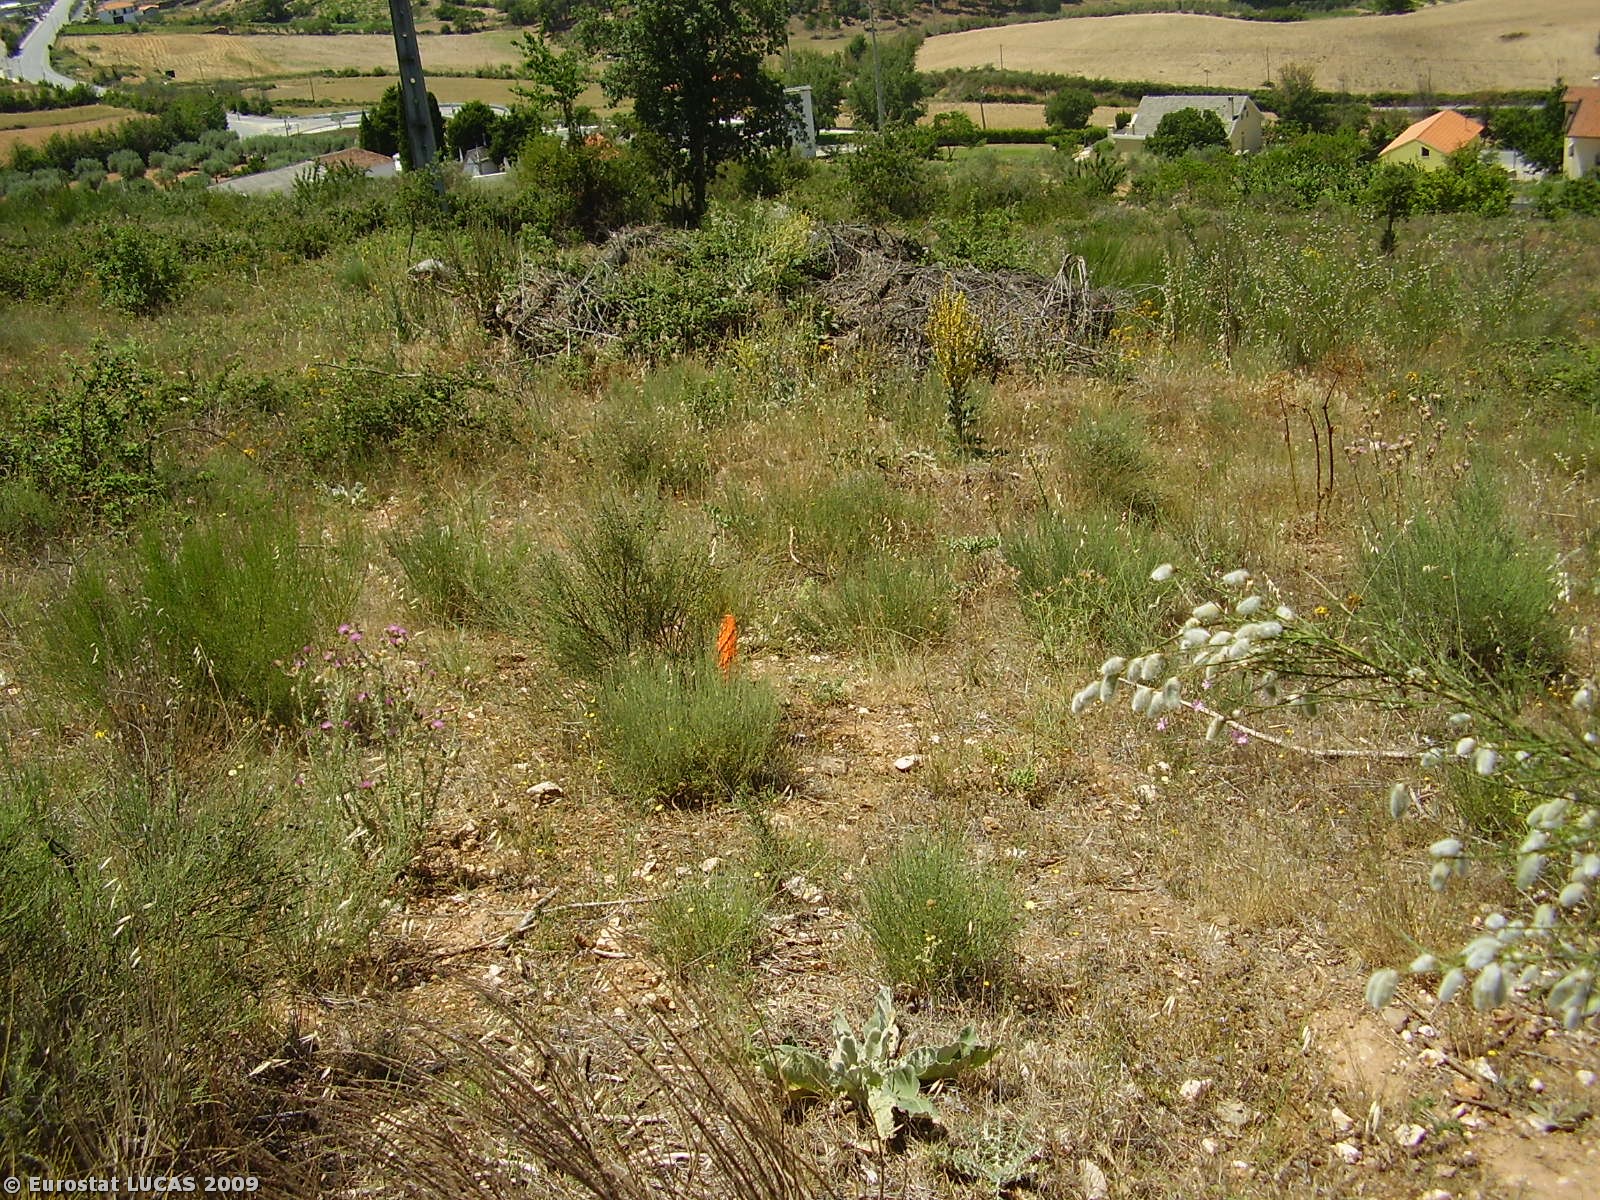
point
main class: Shrubland
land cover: Shrubland with sparse tree cover
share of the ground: 10 - 25 %
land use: Unused
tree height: > 5 m
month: June
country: PT
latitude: 41.5801
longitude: -6.5246
